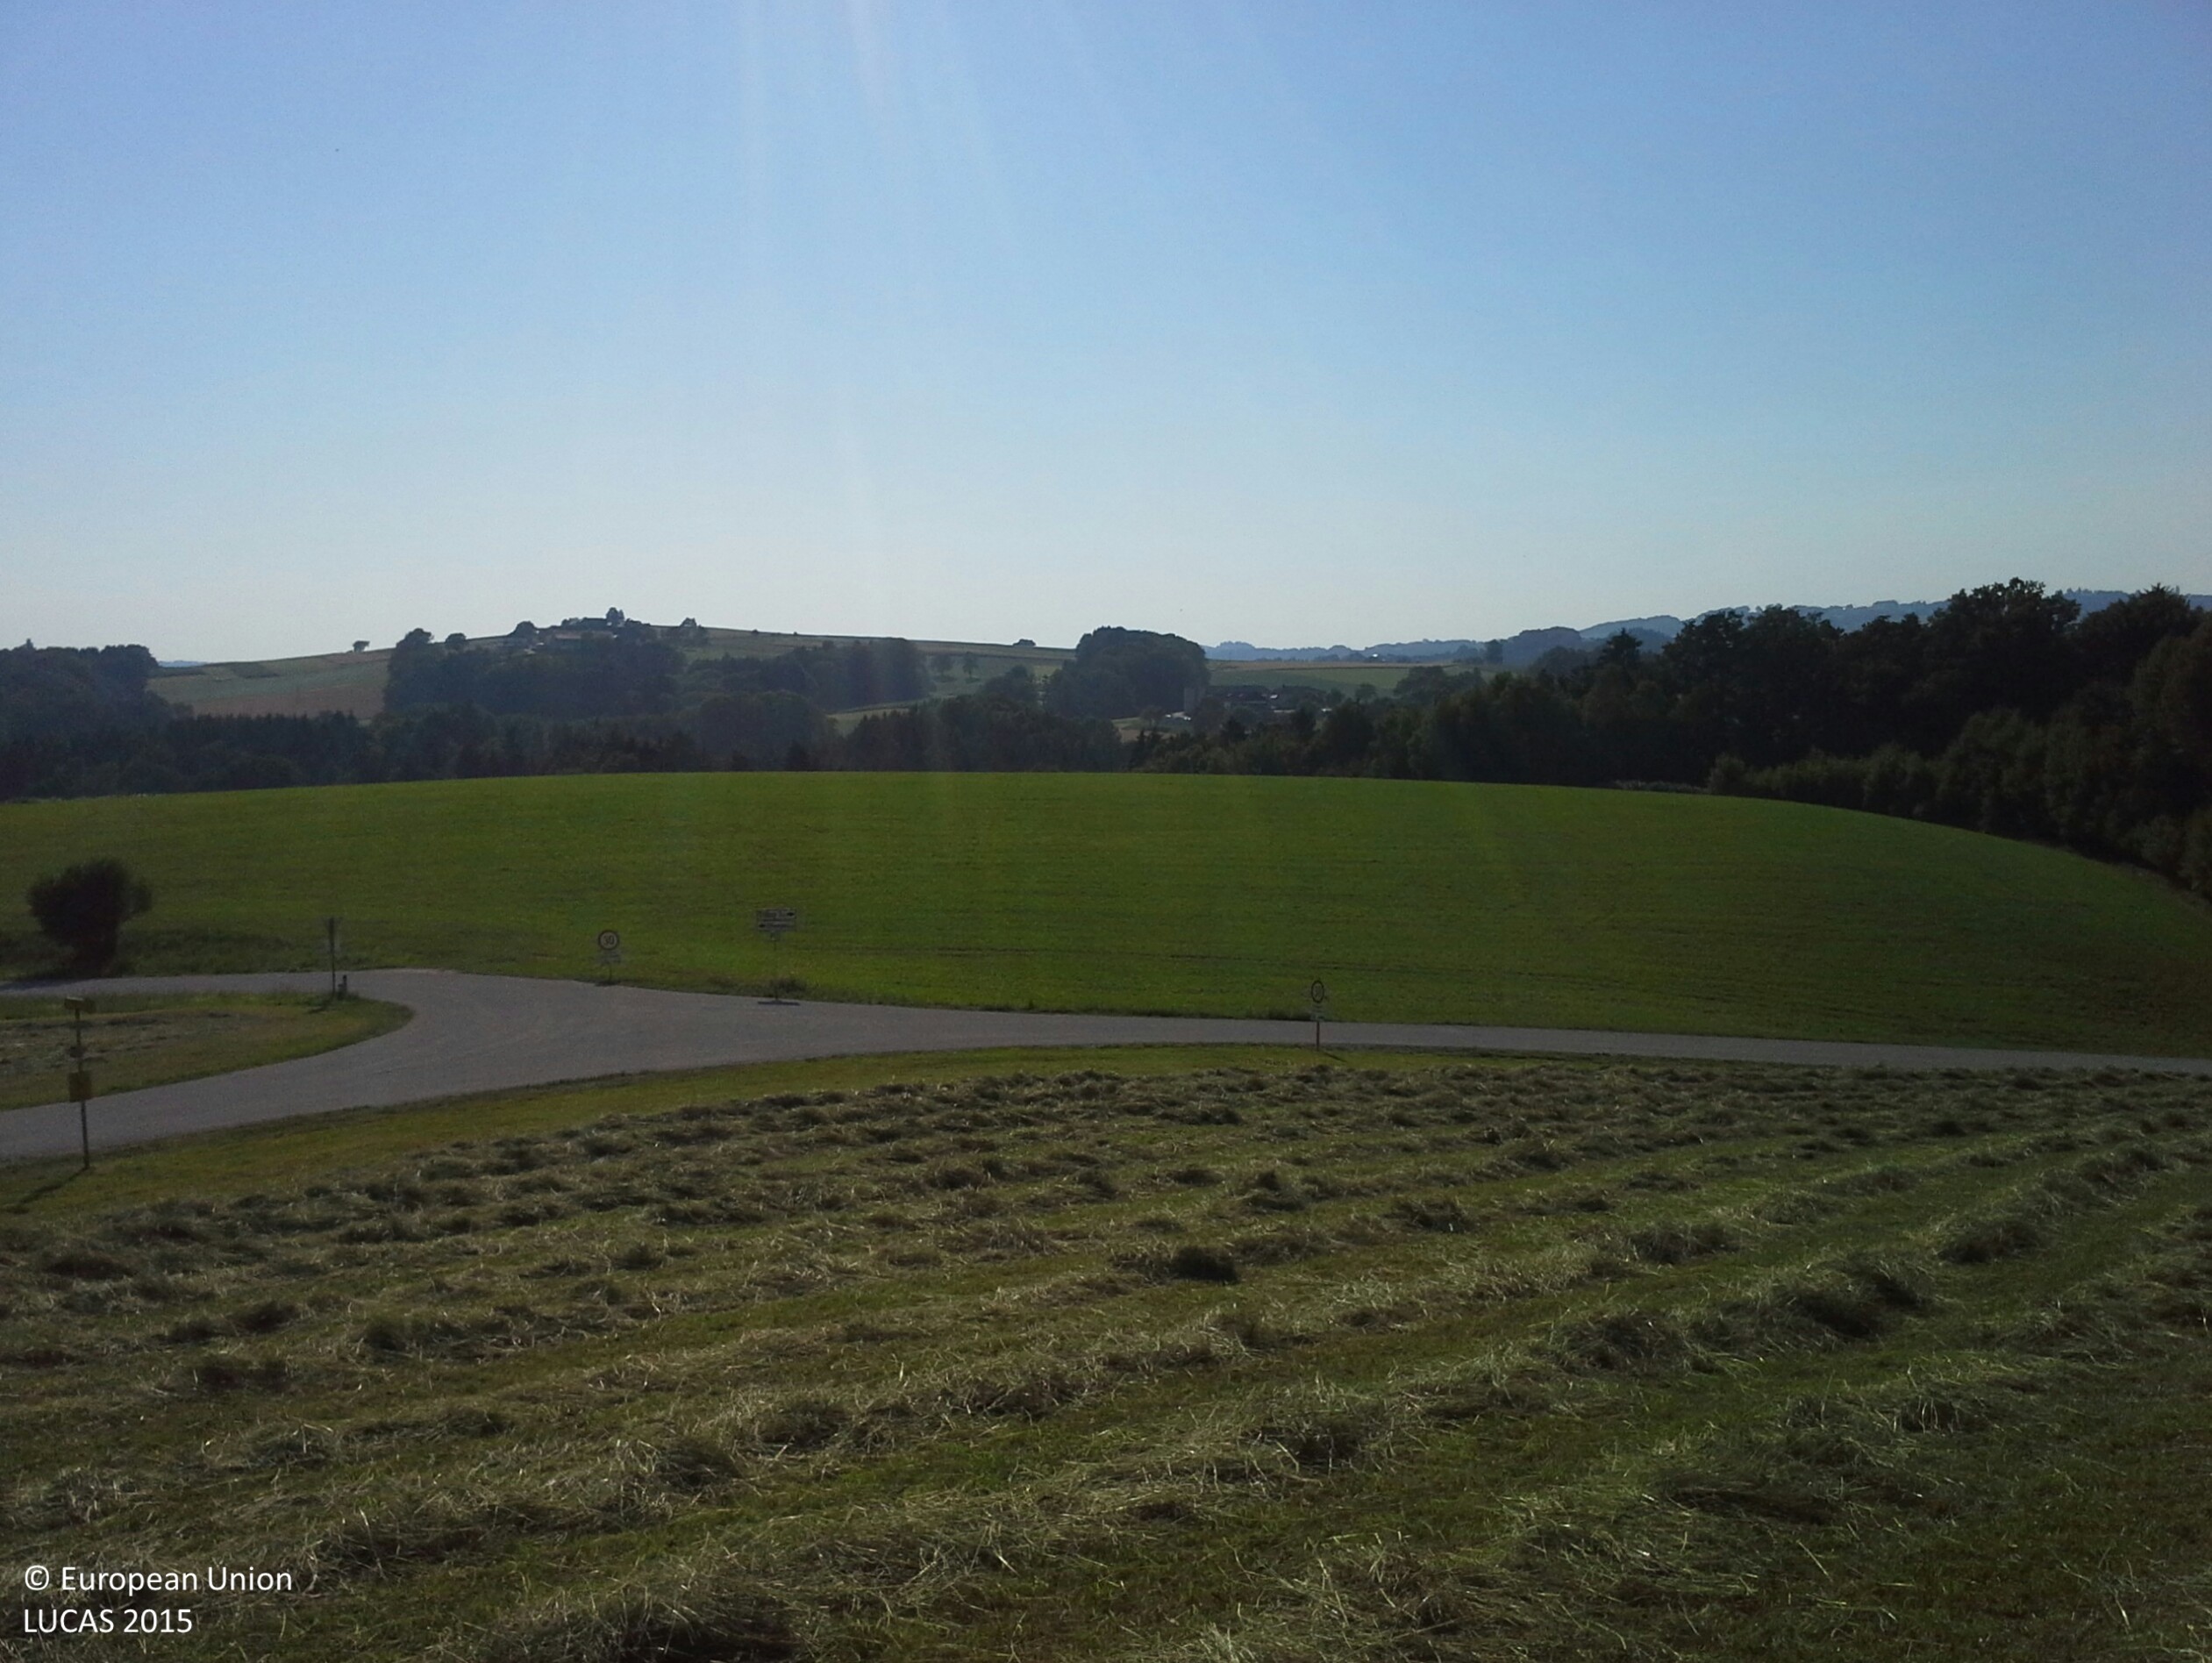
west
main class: Grassland
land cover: Grassland without tree/shrub cover
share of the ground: > 75 %
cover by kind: herbaceous plants 100 %
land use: Agriculture (excluding fallow land and kitchen gardens)
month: July
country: AT
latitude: 48.1659
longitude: 14.9625
